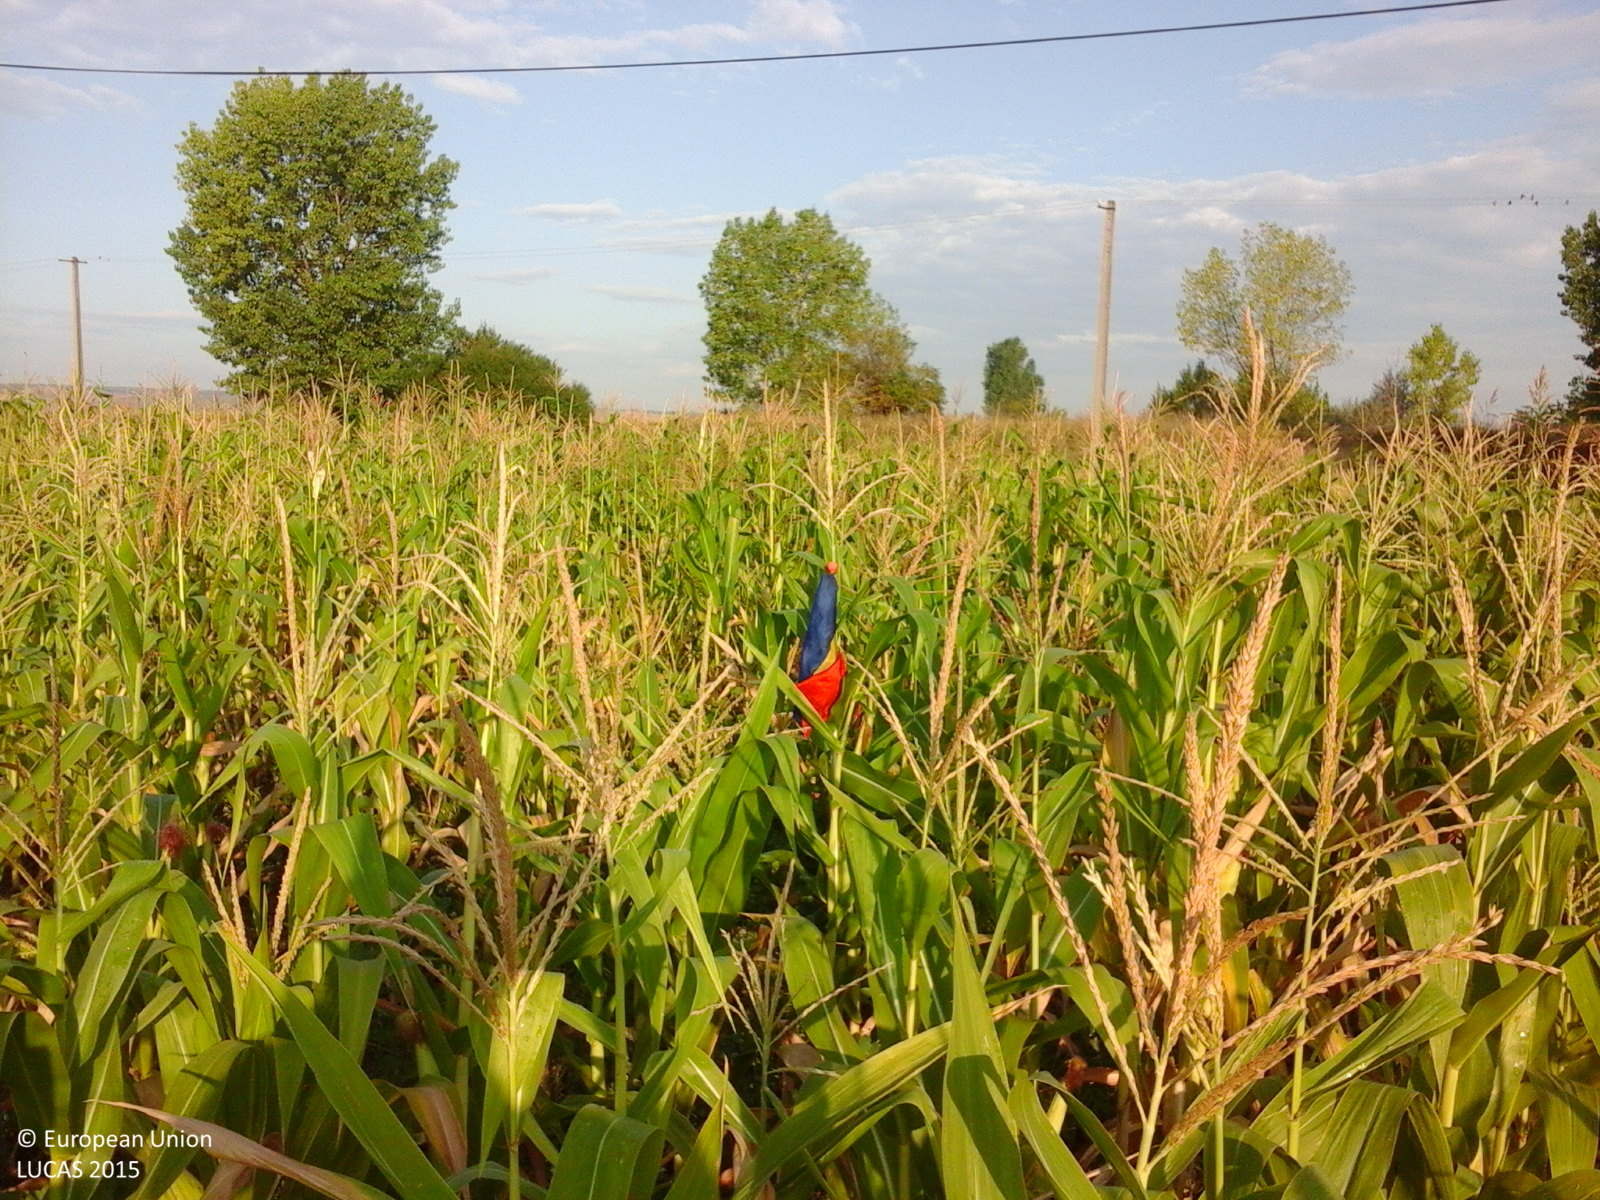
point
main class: Cropland
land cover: Maize
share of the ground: > 75 %
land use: Agriculture (excluding fallow land and kitchen gardens)
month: July
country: RO
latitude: 46.2790
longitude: 28.1290
